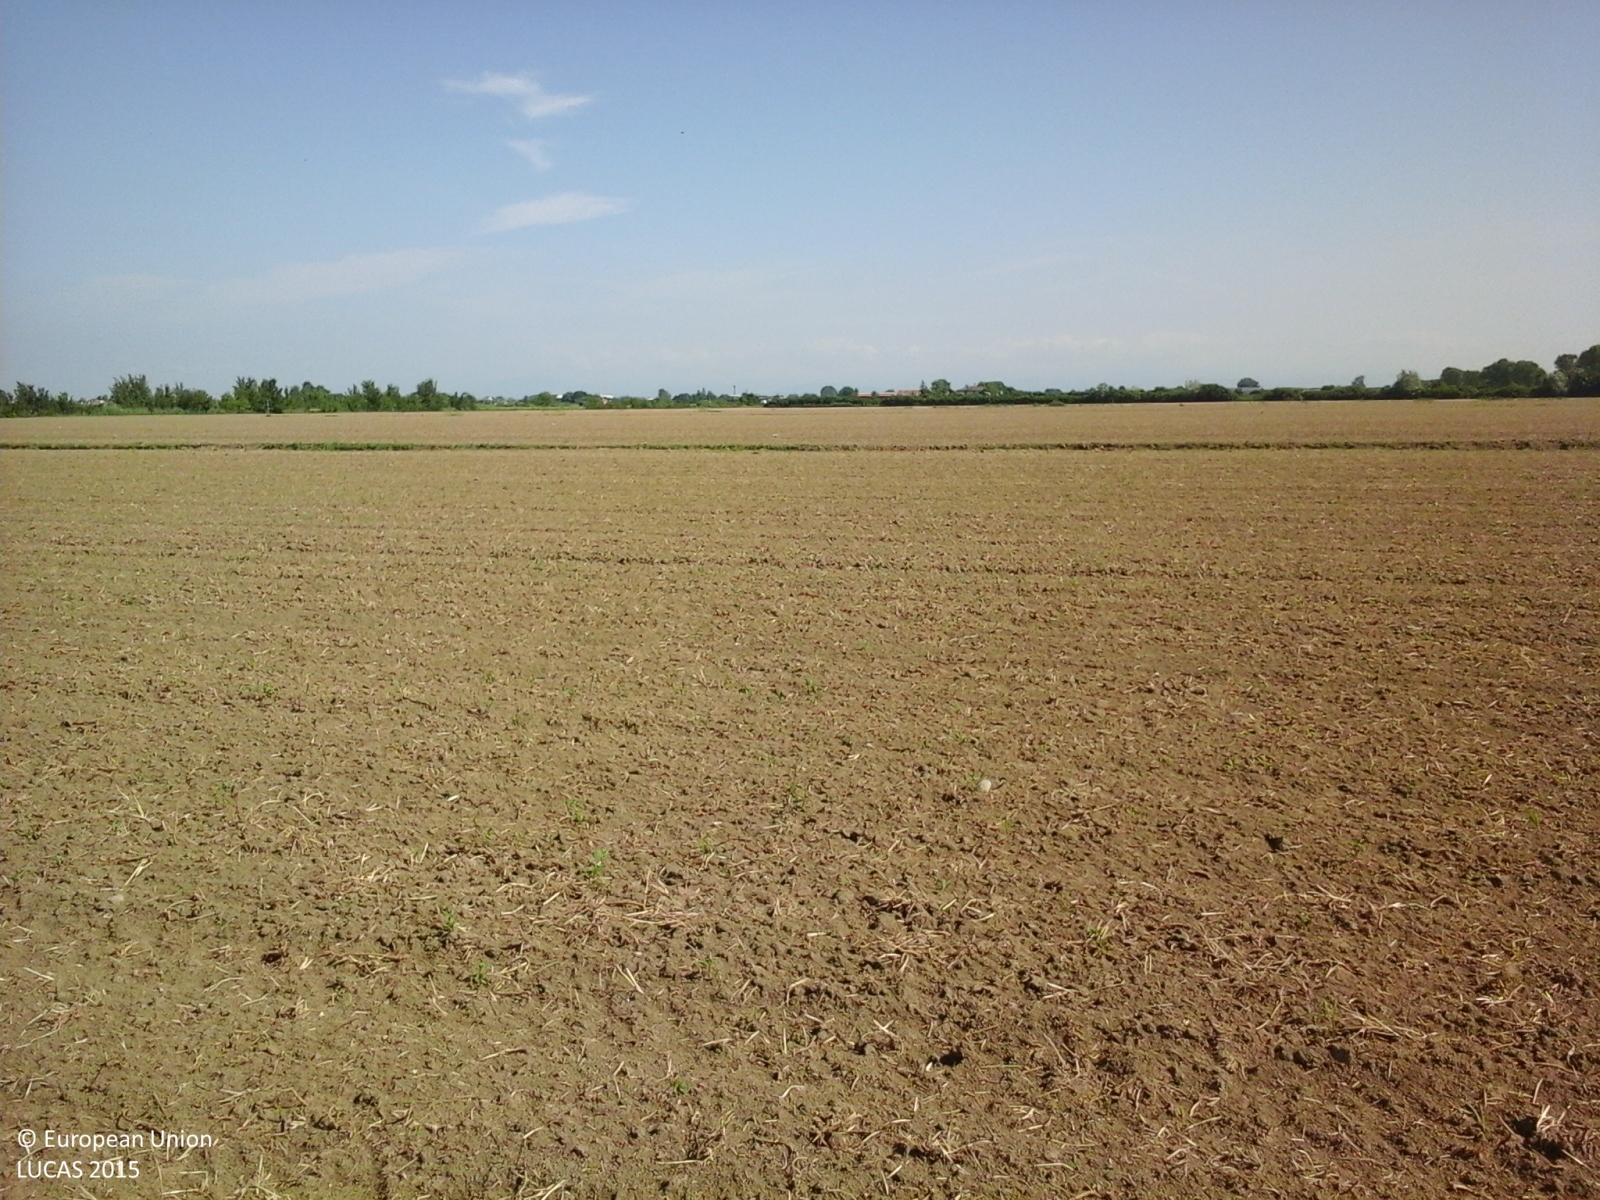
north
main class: Cropland
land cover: Maize
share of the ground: < 10 %
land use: Agriculture (excluding fallow land and kitchen gardens)
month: May
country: IT
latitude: 45.1574
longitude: 10.9777
